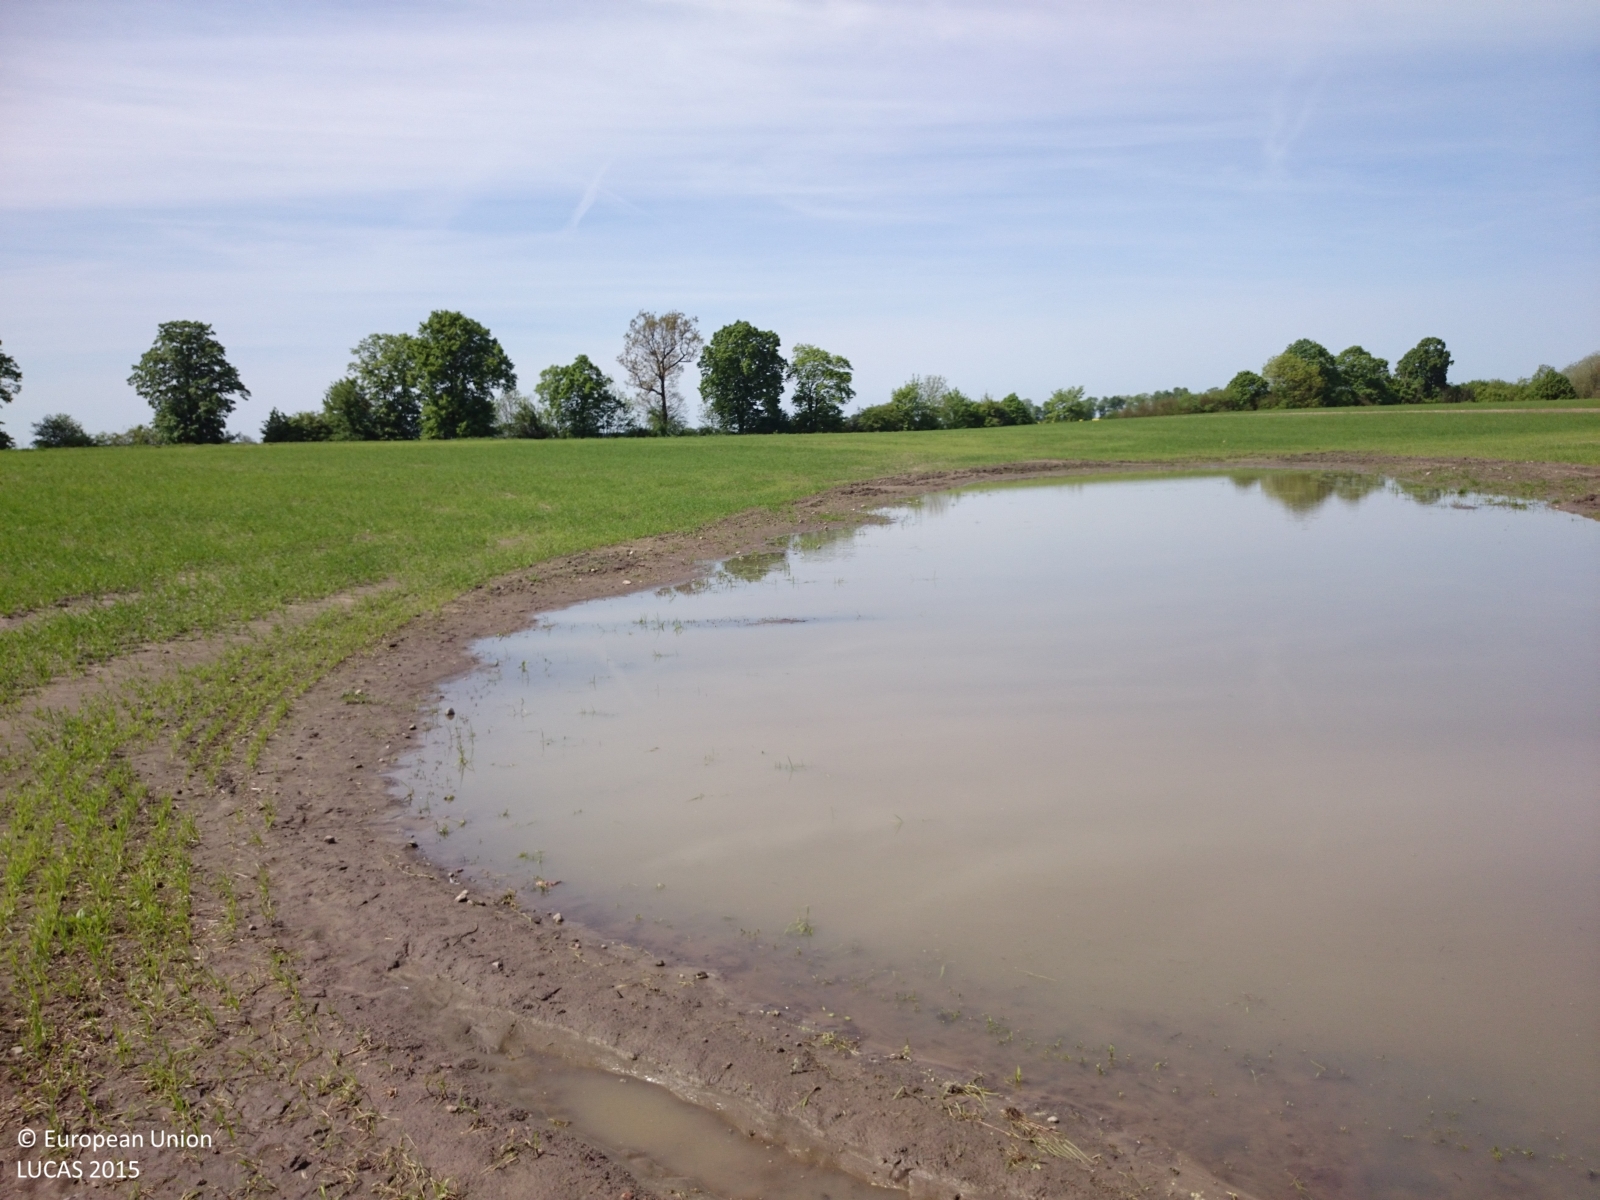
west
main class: Cropland
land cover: Rye
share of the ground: 10 - 25 %
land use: Agriculture (excluding fallow land and kitchen gardens)
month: May
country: PL
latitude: 52.4483
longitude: 16.2302
